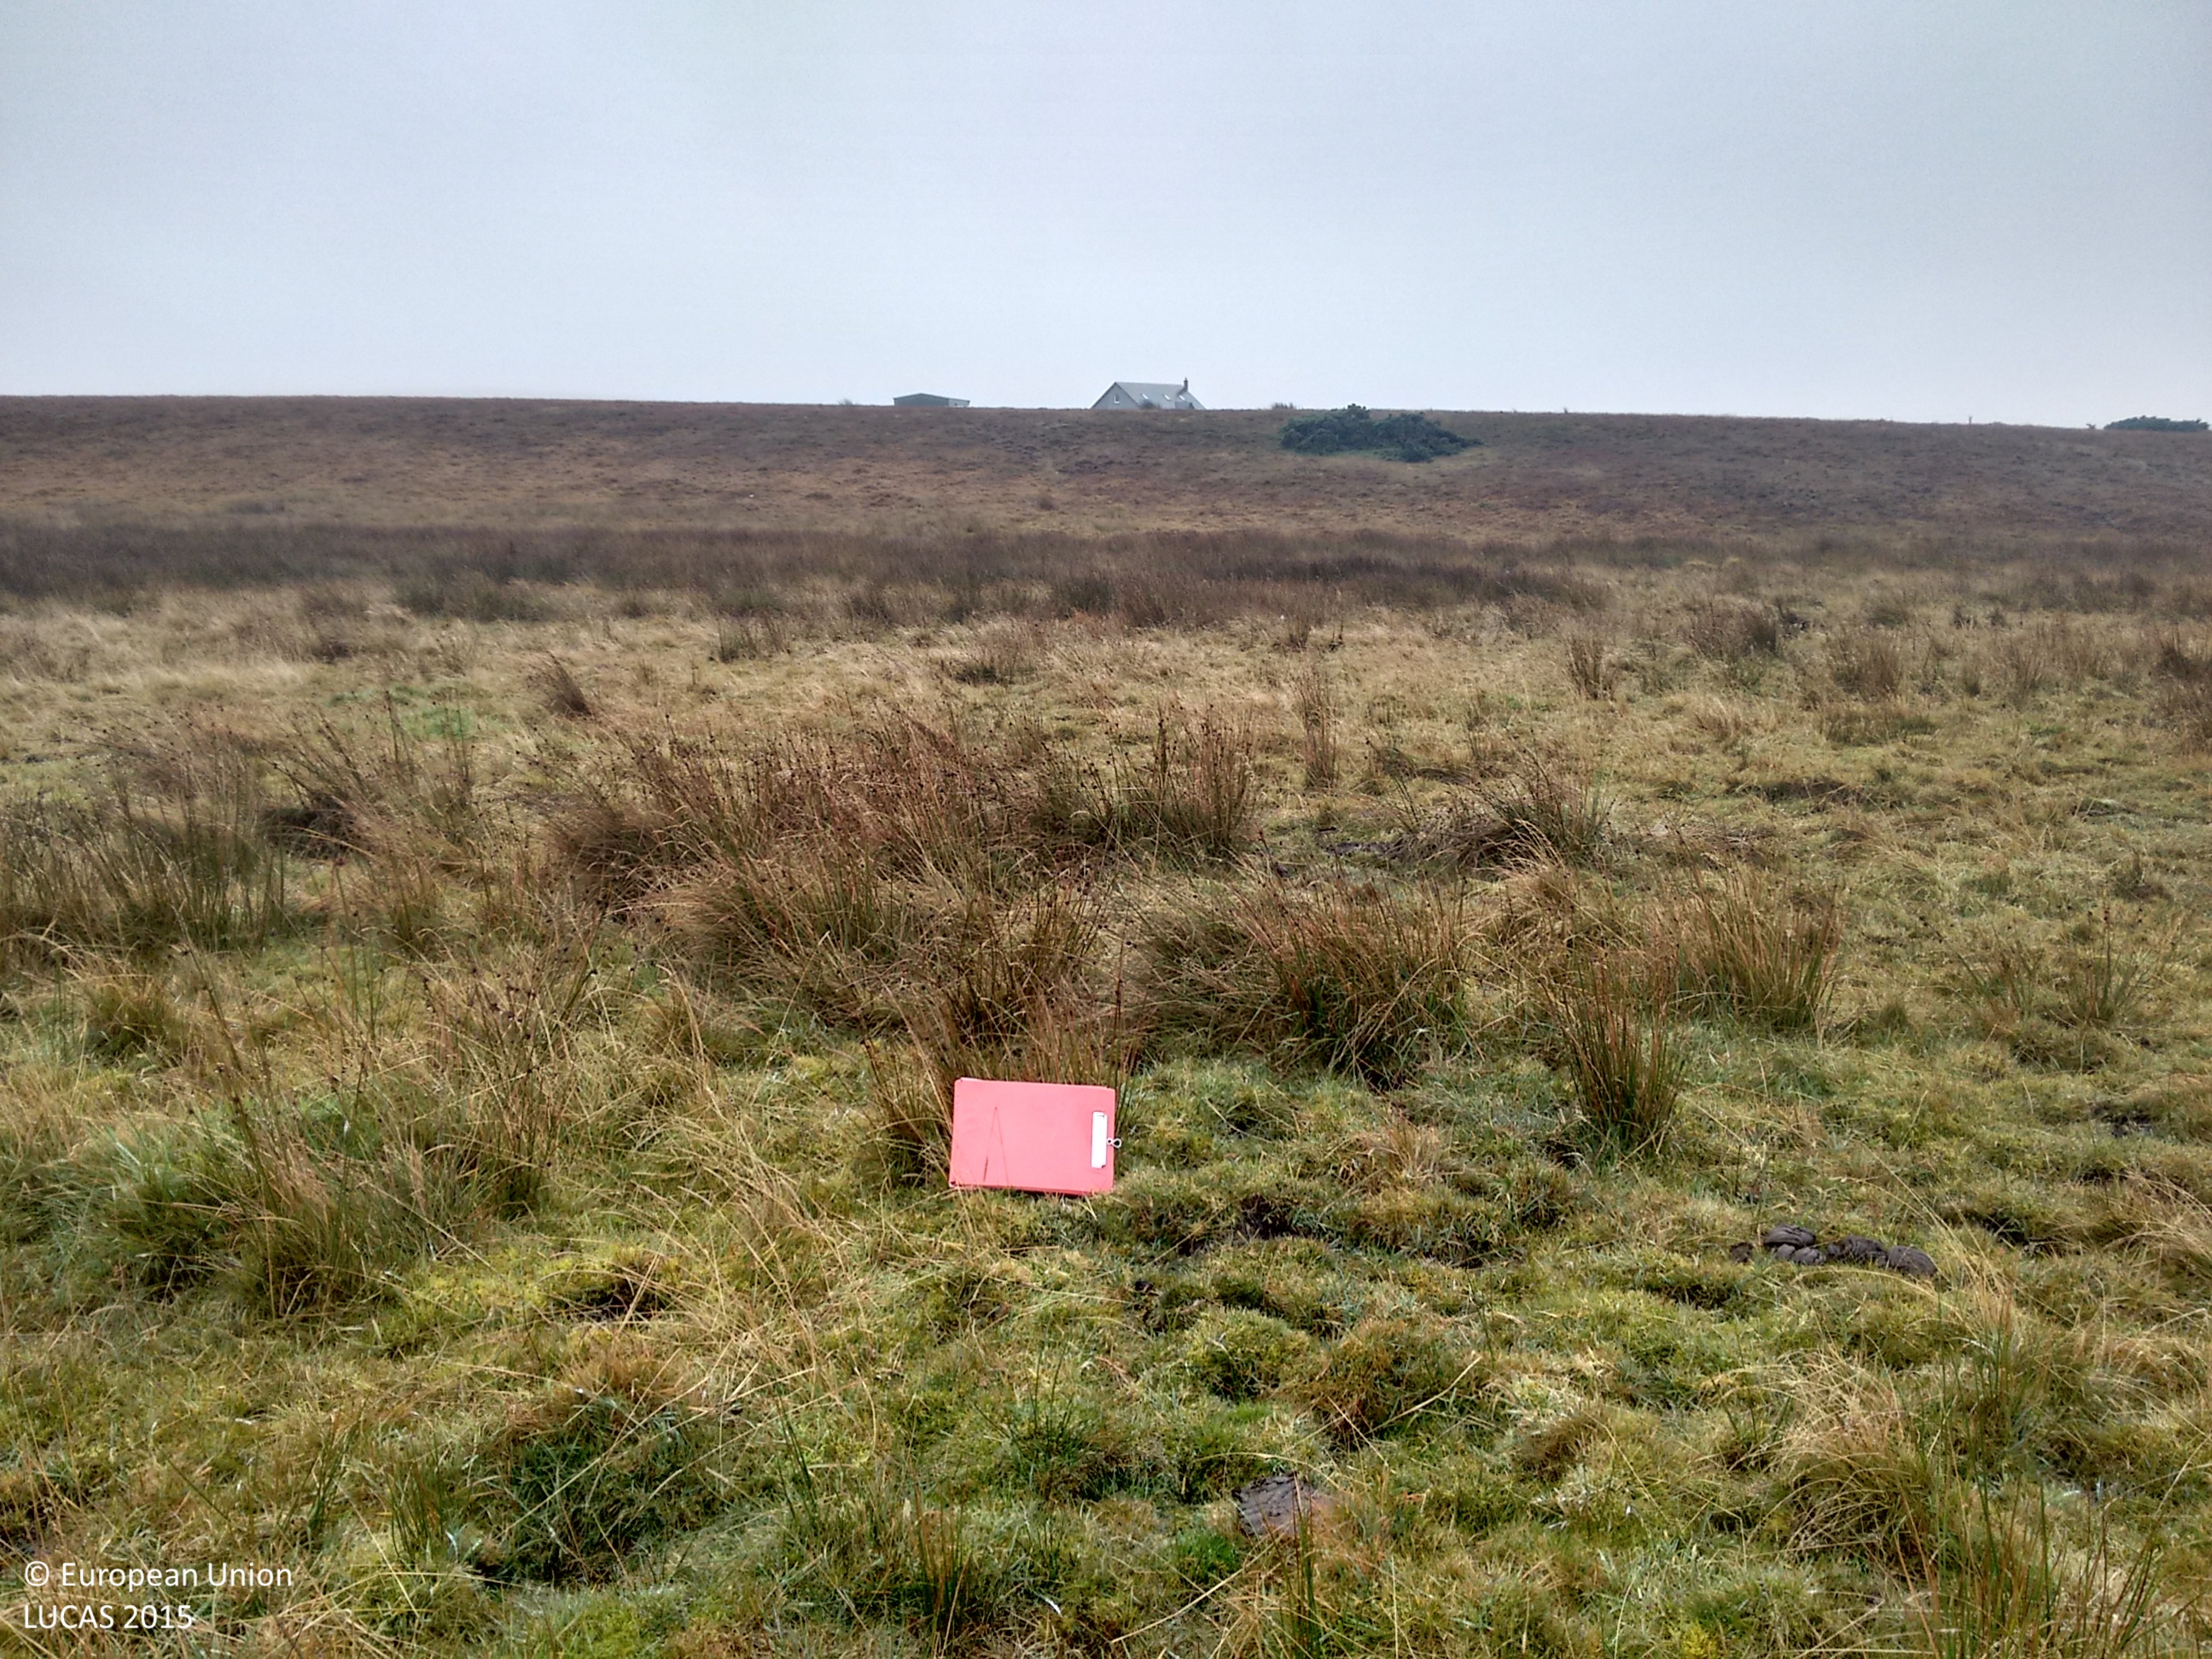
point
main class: Grassland
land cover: Grassland without tree/shrub cover
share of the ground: > 75 %
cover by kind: herbaceous plants 80 %, lichens and mosses 20 %
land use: Agriculture (excluding fallow land and kitchen gardens)
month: October
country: GB
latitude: 55.7441
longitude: -6.2814
